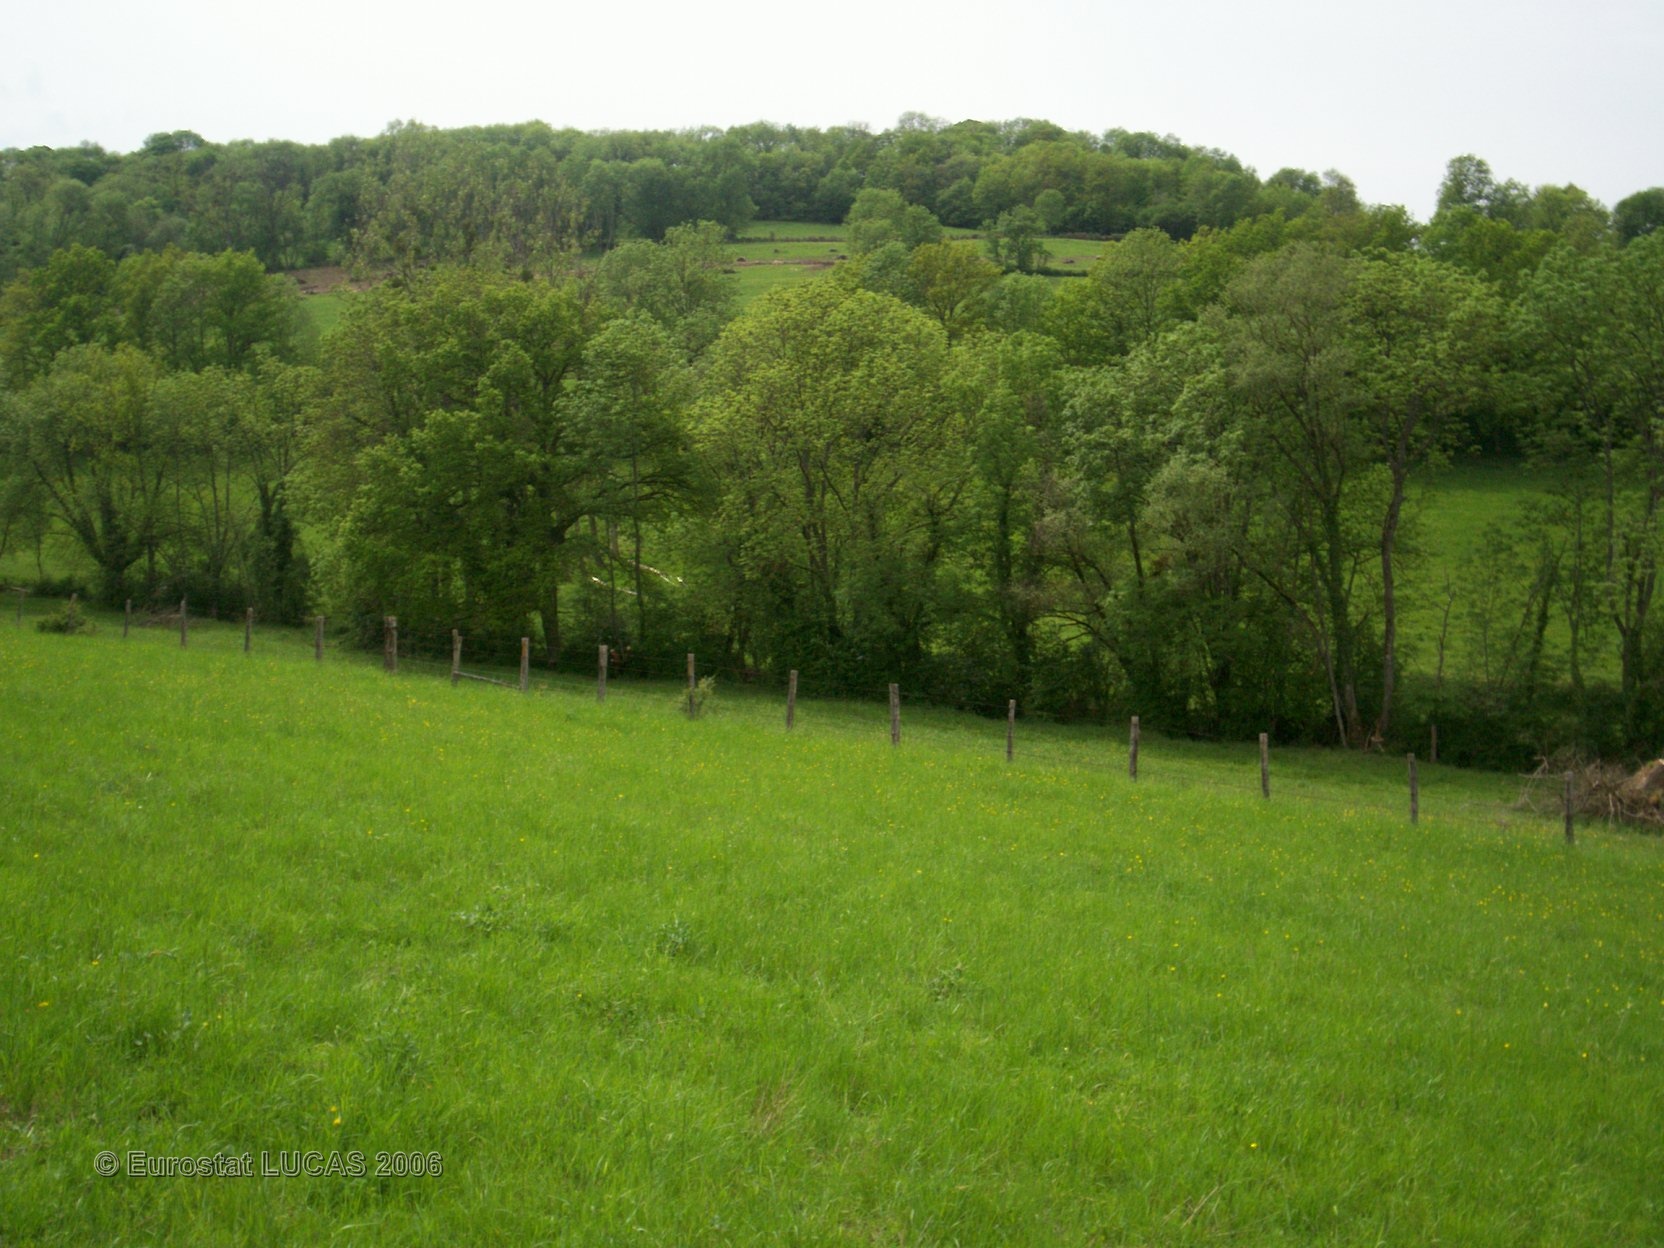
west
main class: Grassland
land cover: Grassland without tree/shrub cover
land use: Agriculture (excluding fallow land and kitchen gardens)
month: May
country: FR
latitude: 47.2997
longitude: 4.6436
